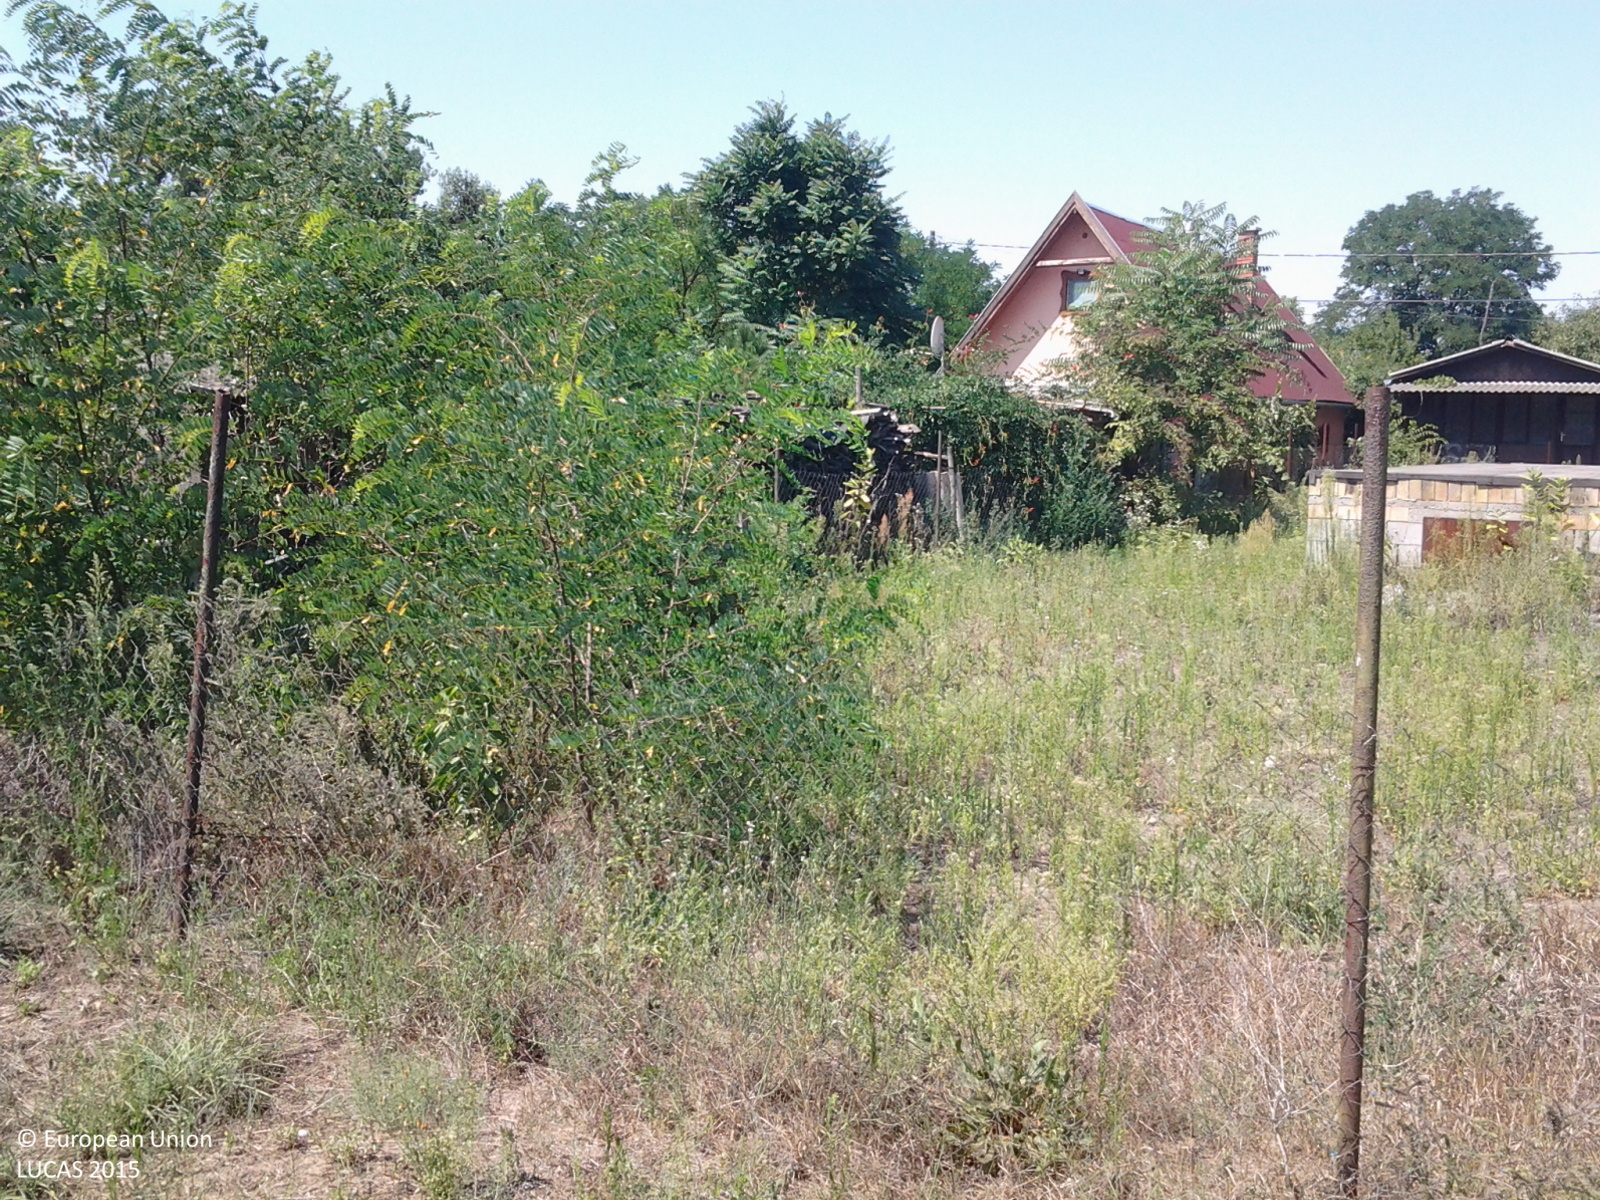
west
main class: Grassland
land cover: Spontaneously vegetated surfaces
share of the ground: > 75 %
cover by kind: herbaceous plants 100 %
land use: Fallow land
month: August
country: HU
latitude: 47.3349
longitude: 19.7766
